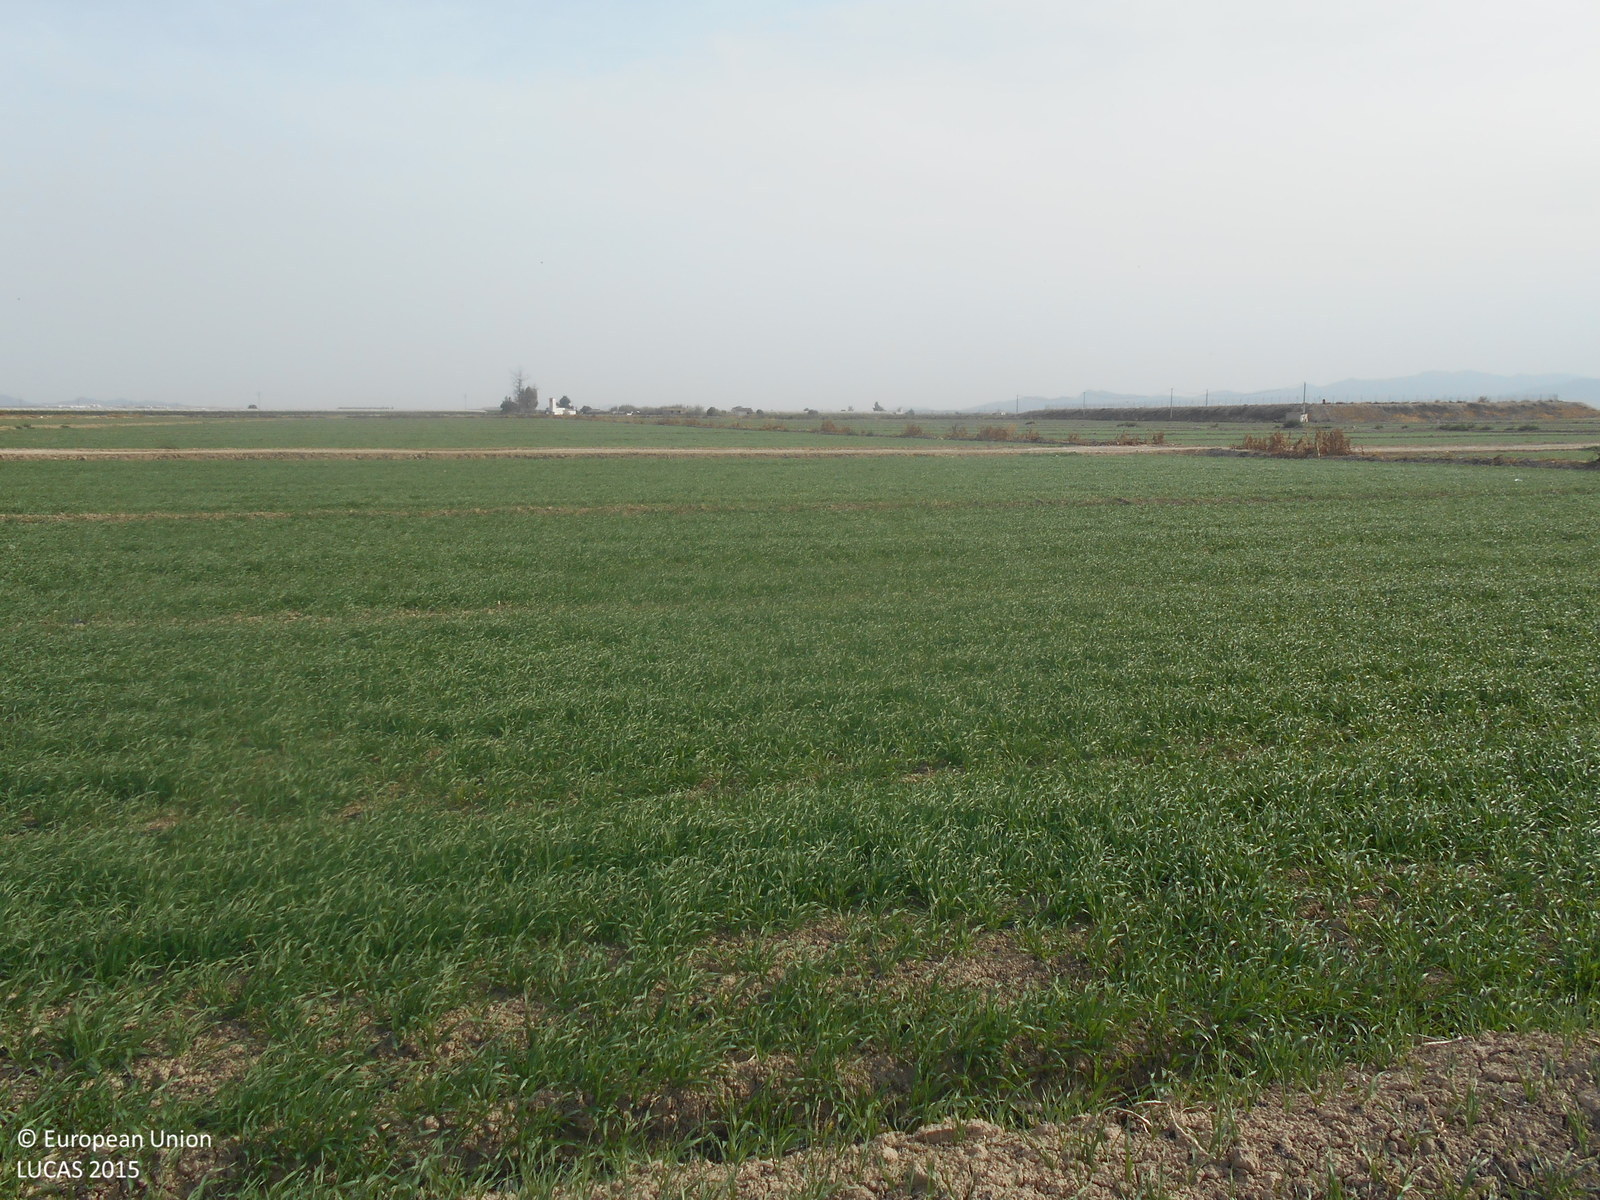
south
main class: Cropland
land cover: Barley
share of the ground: > 75 %
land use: Agriculture (excluding fallow land and kitchen gardens)
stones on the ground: < 10 %
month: April
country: ES
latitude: 37.7920
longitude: -1.3953
